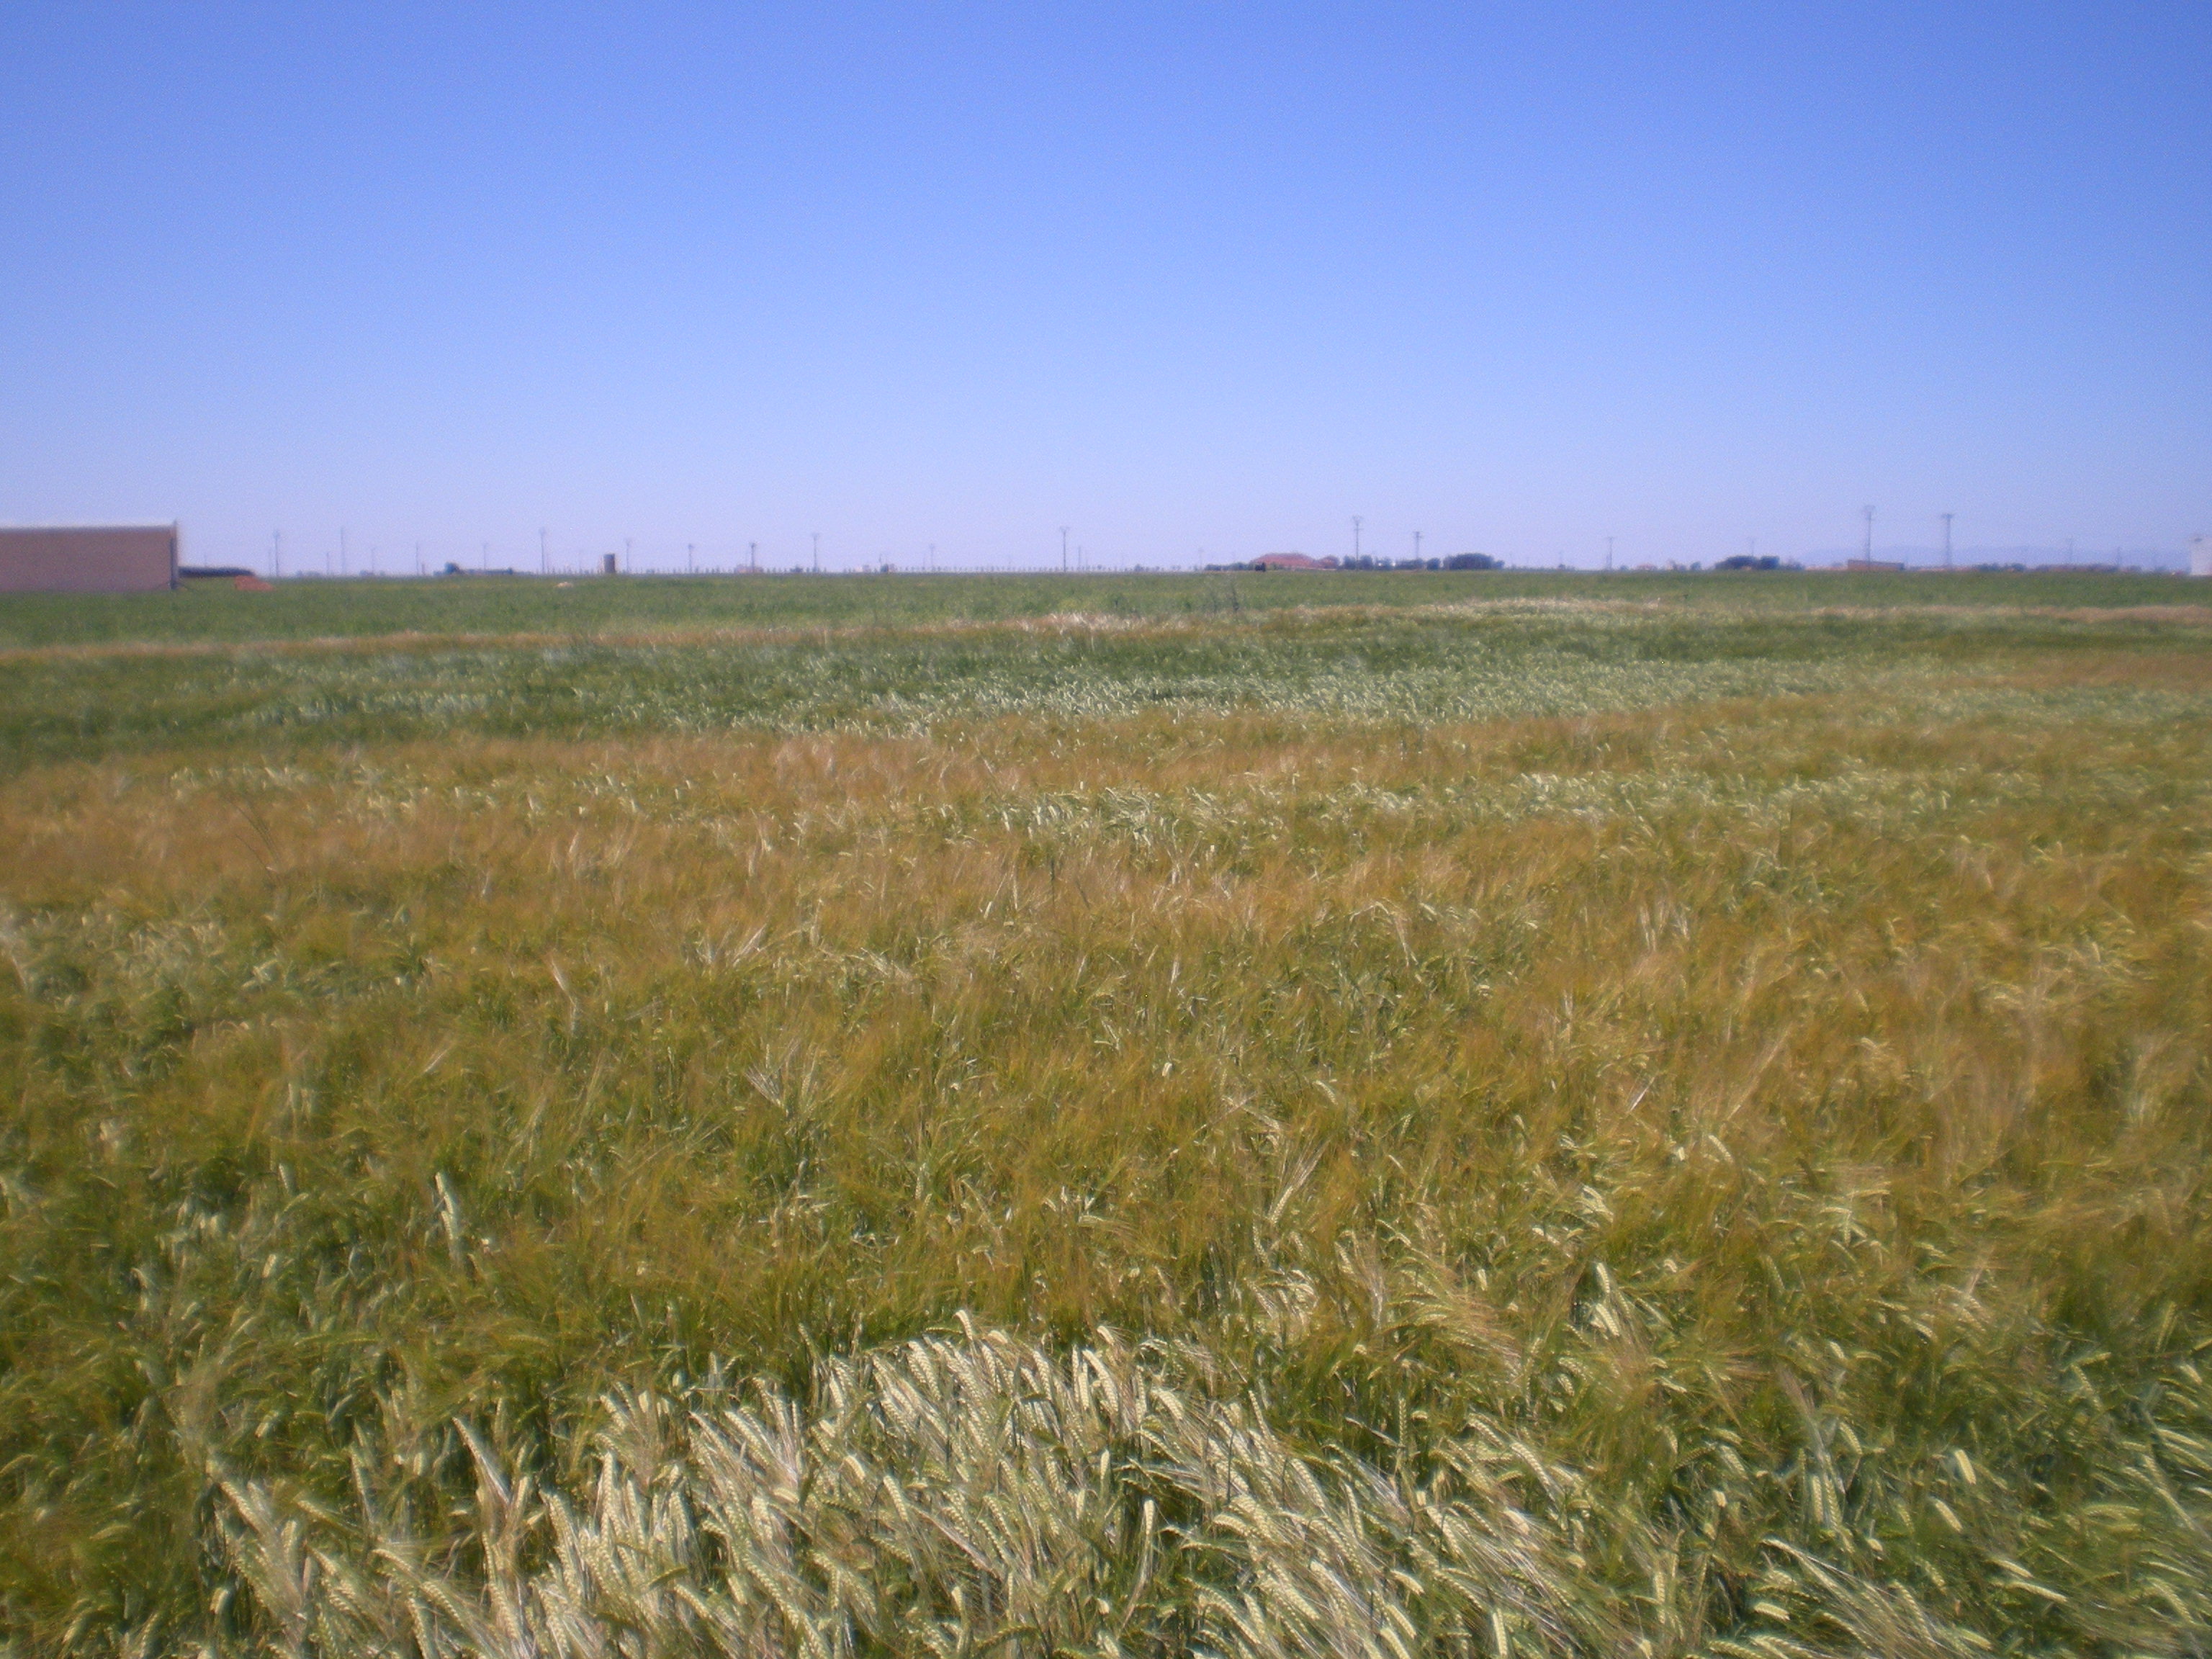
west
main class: Cropland
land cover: Barley
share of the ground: > 75 %
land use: Agriculture (excluding fallow land and kitchen gardens)
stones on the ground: 10 - 25 %
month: May
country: ES
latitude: 39.1437
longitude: -3.1225
